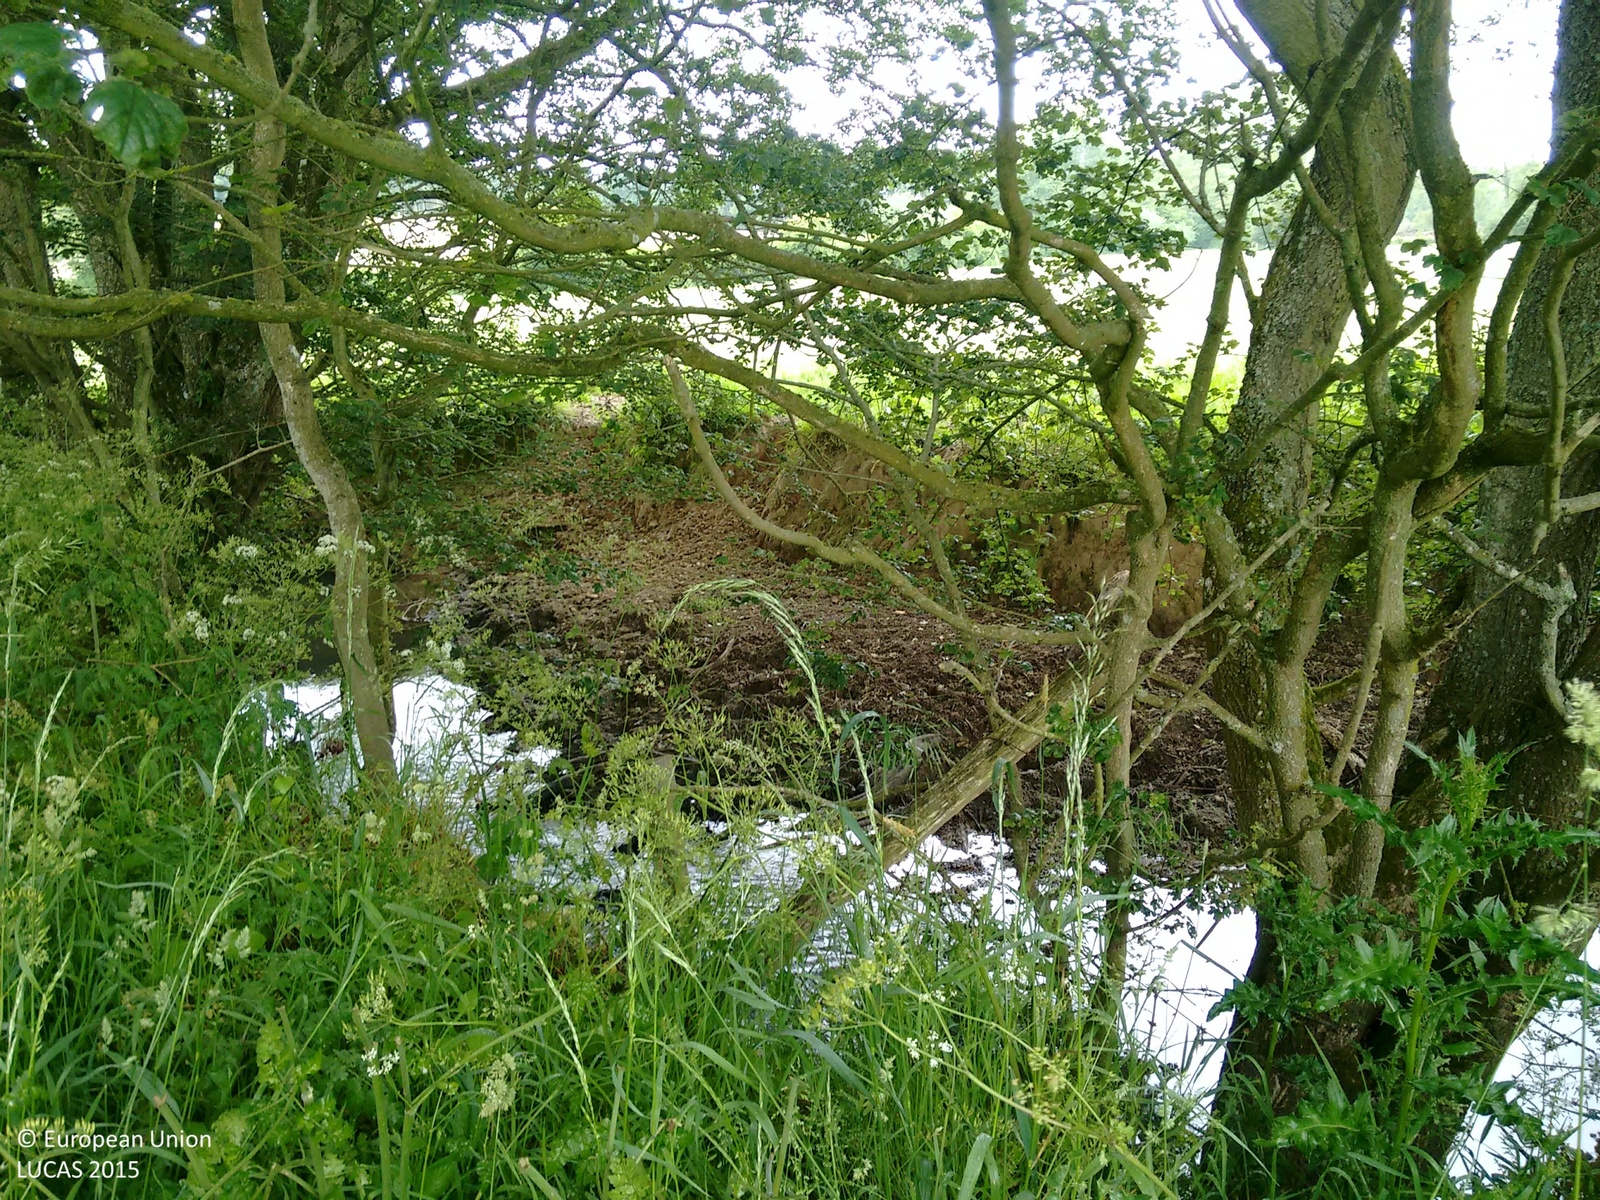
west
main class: Grassland
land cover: Grassland without tree/shrub cover
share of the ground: > 75 %
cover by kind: herbaceous plants 100 %
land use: Agriculture (excluding fallow land and kitchen gardens)
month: June
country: GB
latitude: 51.0235
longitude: 0.3473
